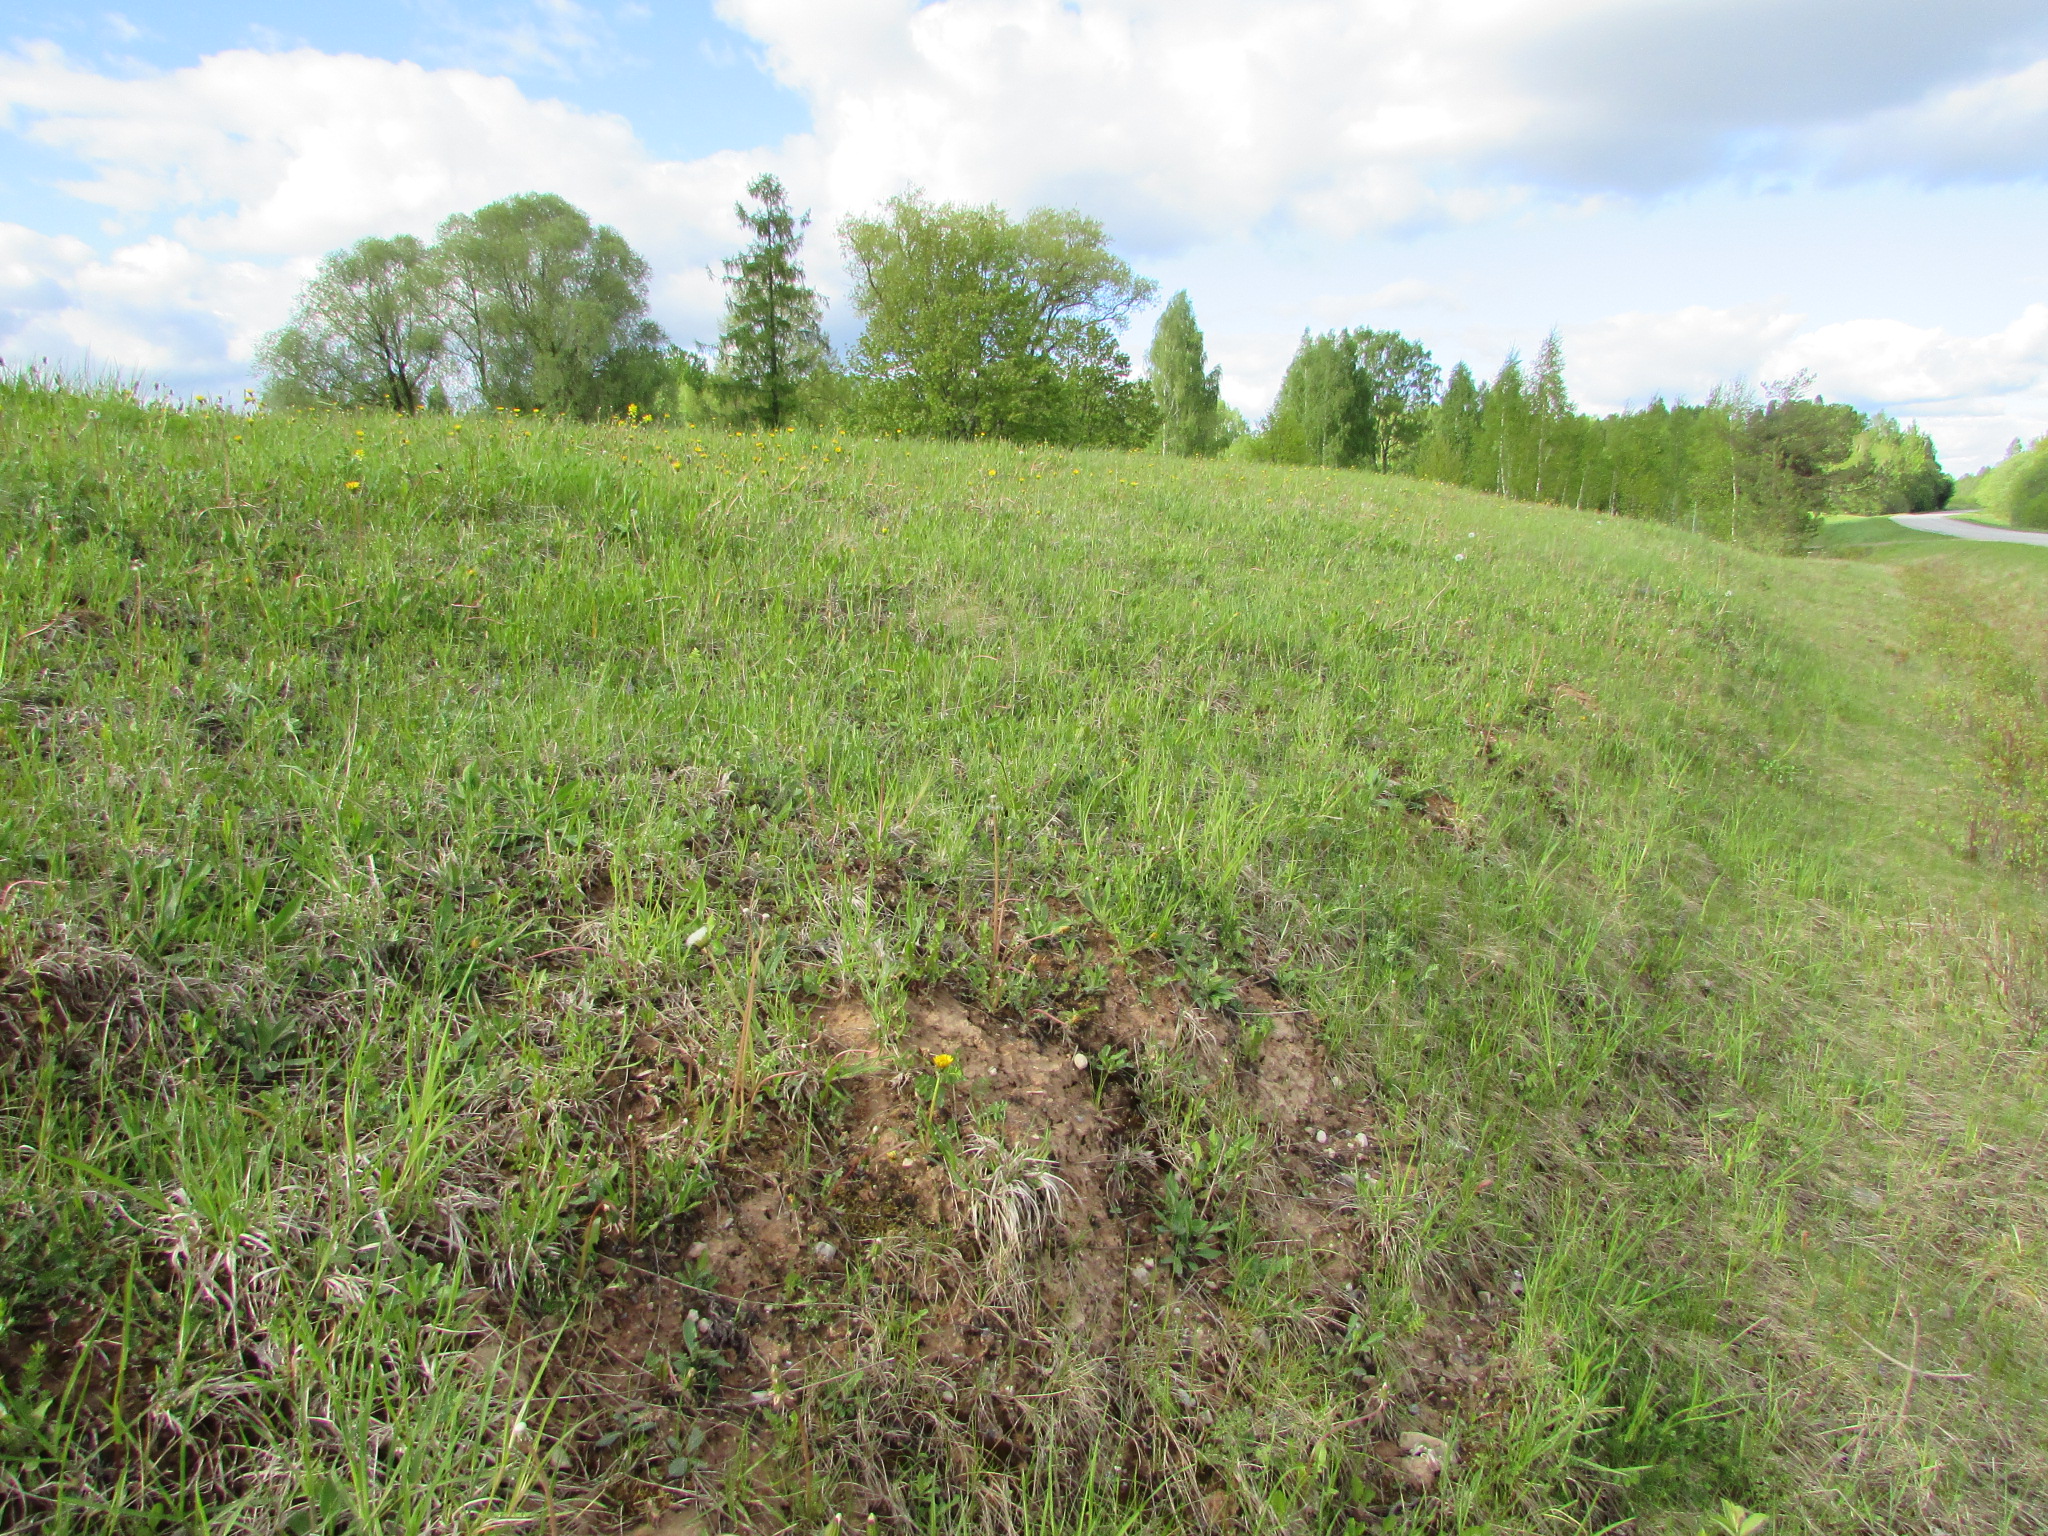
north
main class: Grassland
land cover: Grassland without tree/shrub cover
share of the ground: > 75 %
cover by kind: herbaceous plants 100 %
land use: Agriculture (excluding fallow land and kitchen gardens)
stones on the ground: < 10 %
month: May
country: LV
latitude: 56.1356
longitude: 27.0791
